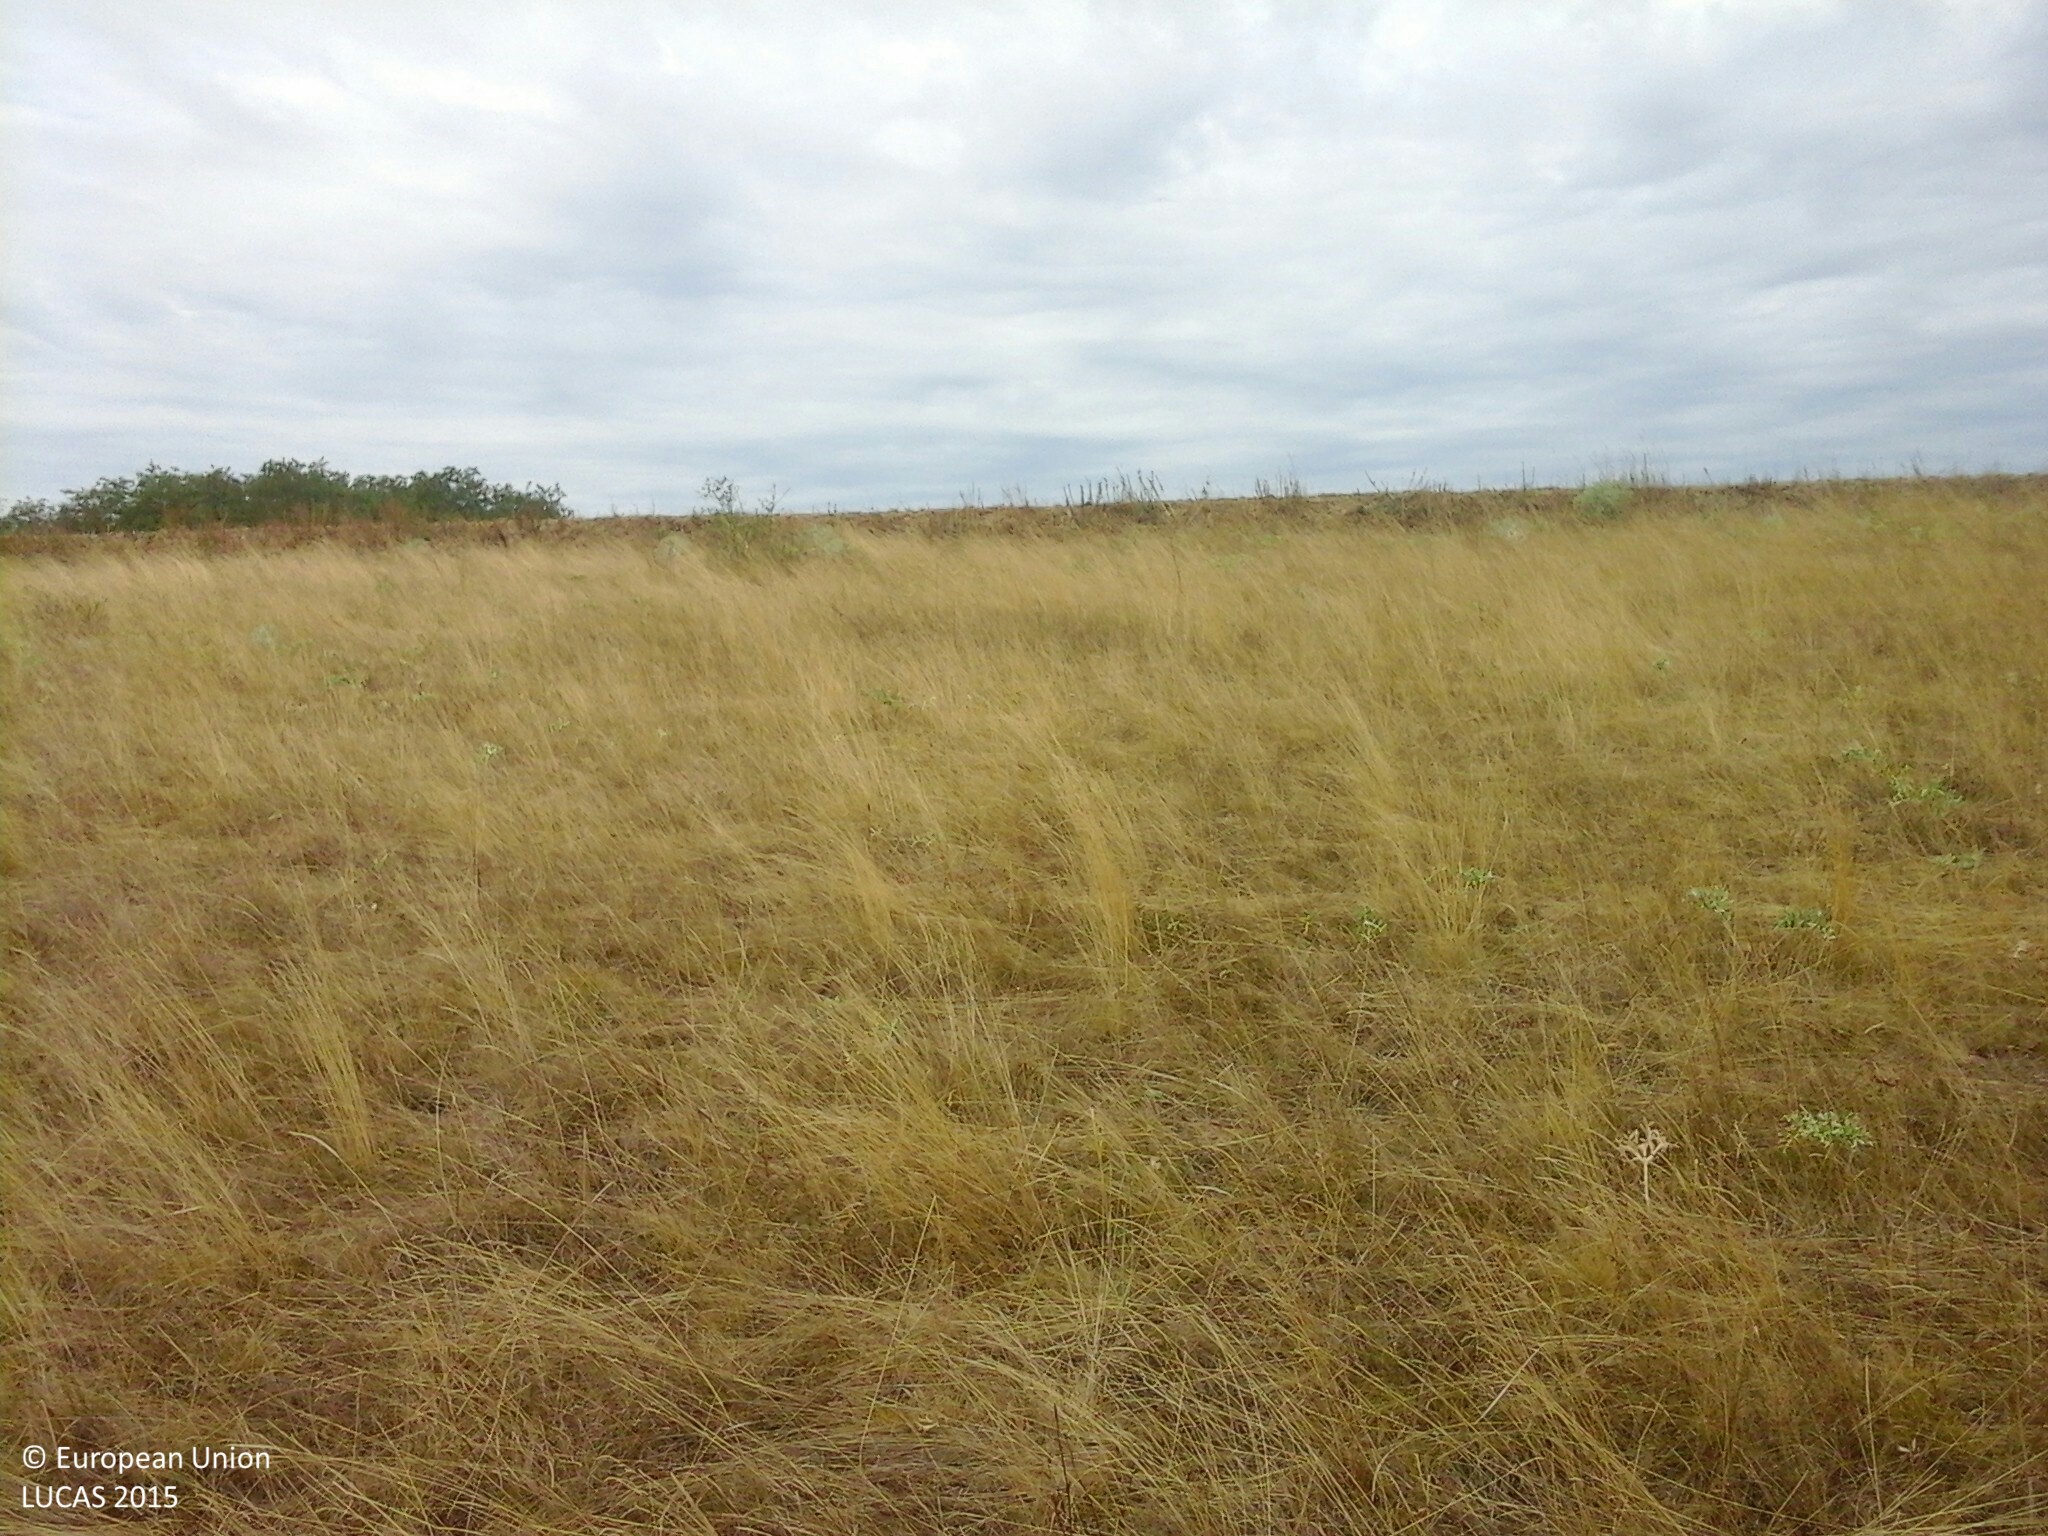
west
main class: Grassland
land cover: Grassland without tree/shrub cover
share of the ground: > 75 %
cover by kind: herbaceous plants 100 %
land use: Agriculture (excluding fallow land and kitchen gardens)
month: July
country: HU
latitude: 47.8708
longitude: 20.6360
